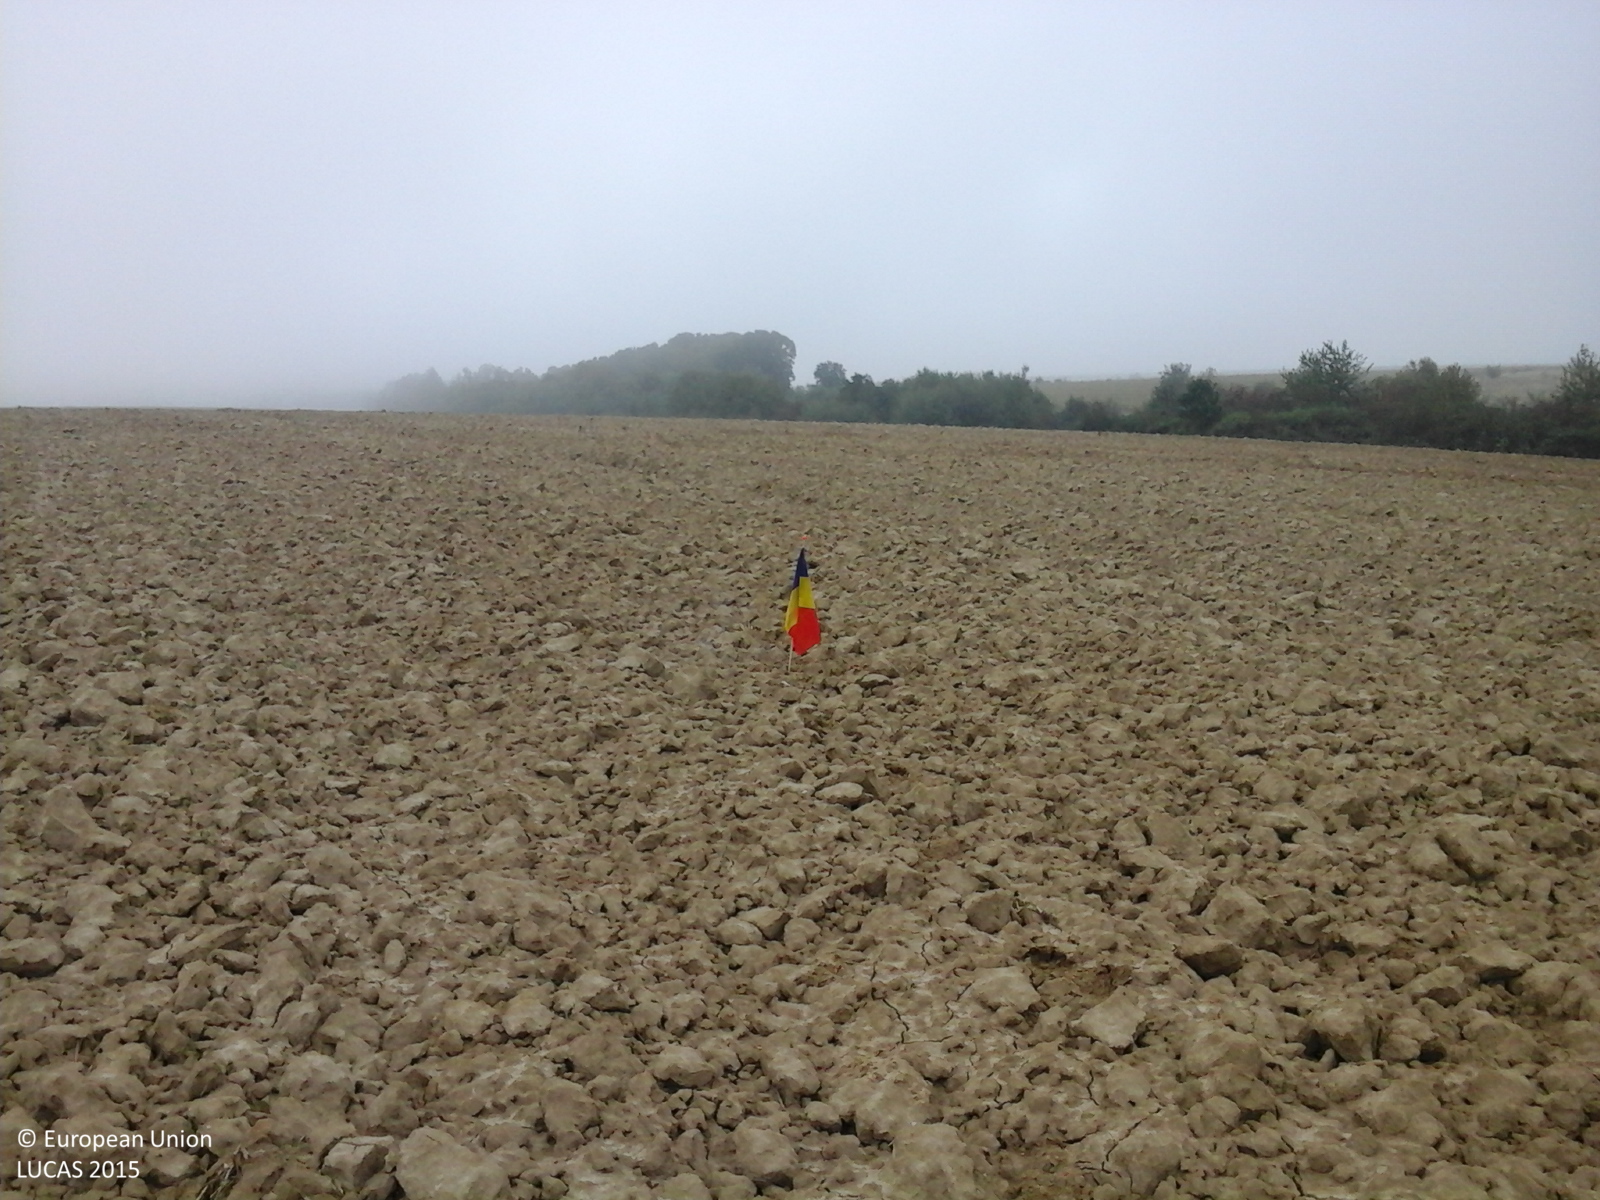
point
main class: Cropland
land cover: Common wheat
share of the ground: < 10 %
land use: Agriculture (excluding fallow land and kitchen gardens)
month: September
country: RO
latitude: 45.5616
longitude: 22.0180
